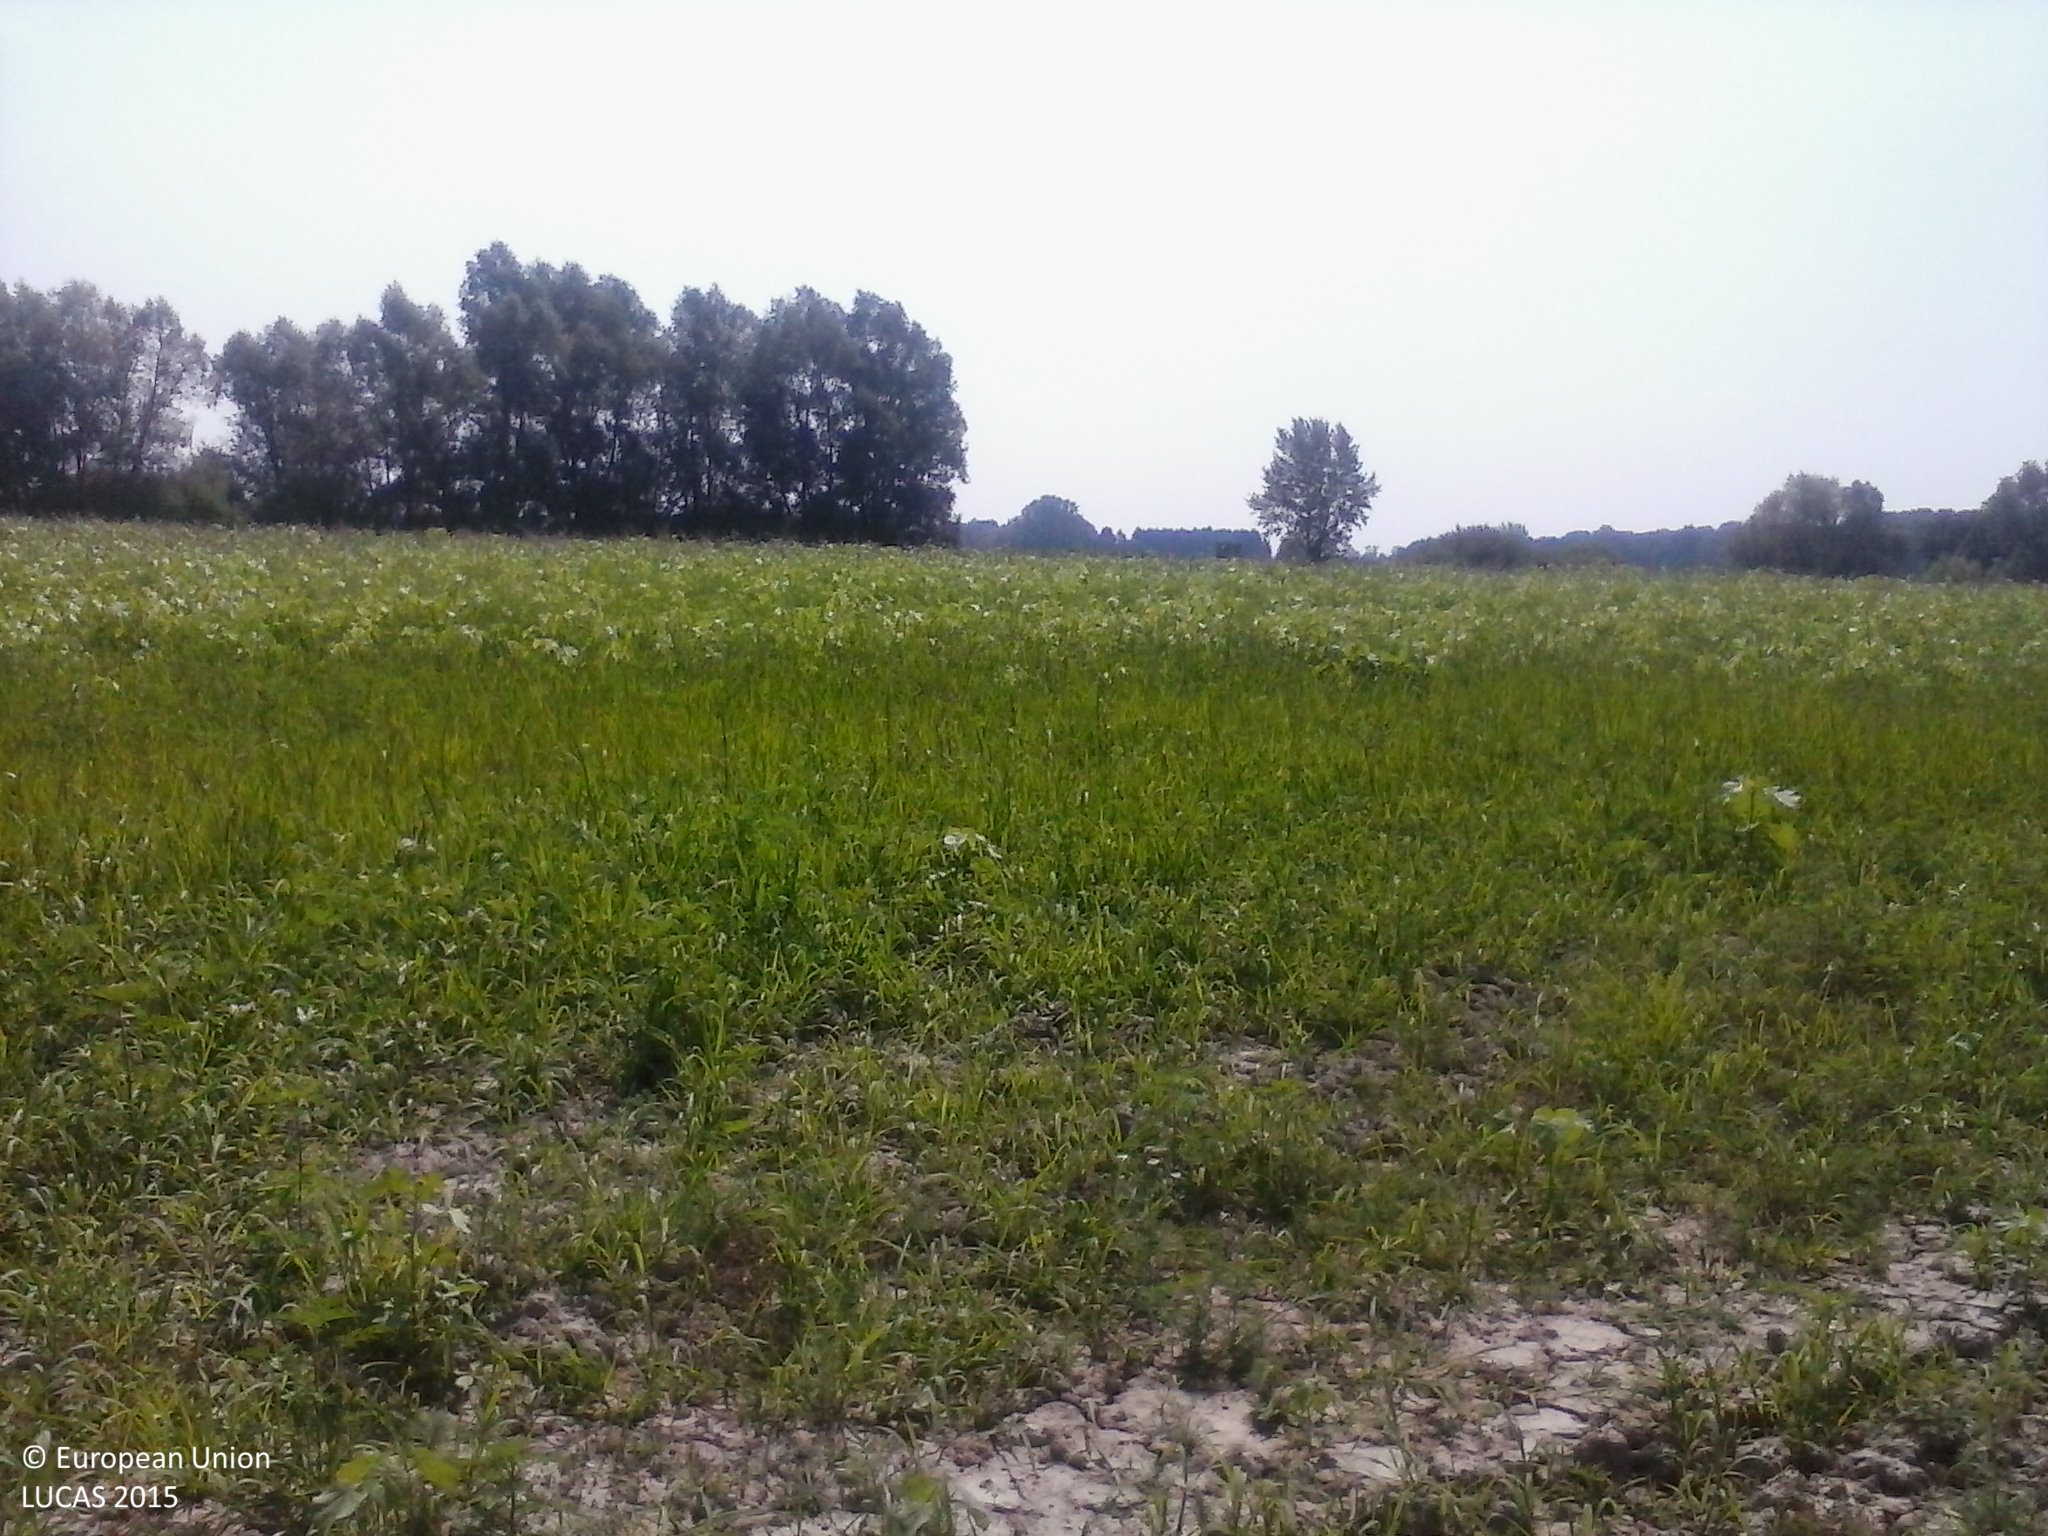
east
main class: Grassland
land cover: Spontaneously vegetated surfaces
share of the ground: > 75 %
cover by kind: herbaceous plants 80 %, unconsolidated bare surface 20 %
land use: Fallow land
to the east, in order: Spontaneously vegetated surfaces; Broadleaved woodland; Grass margins; Sunflower
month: August
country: HU
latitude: 45.8673
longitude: 17.7976
